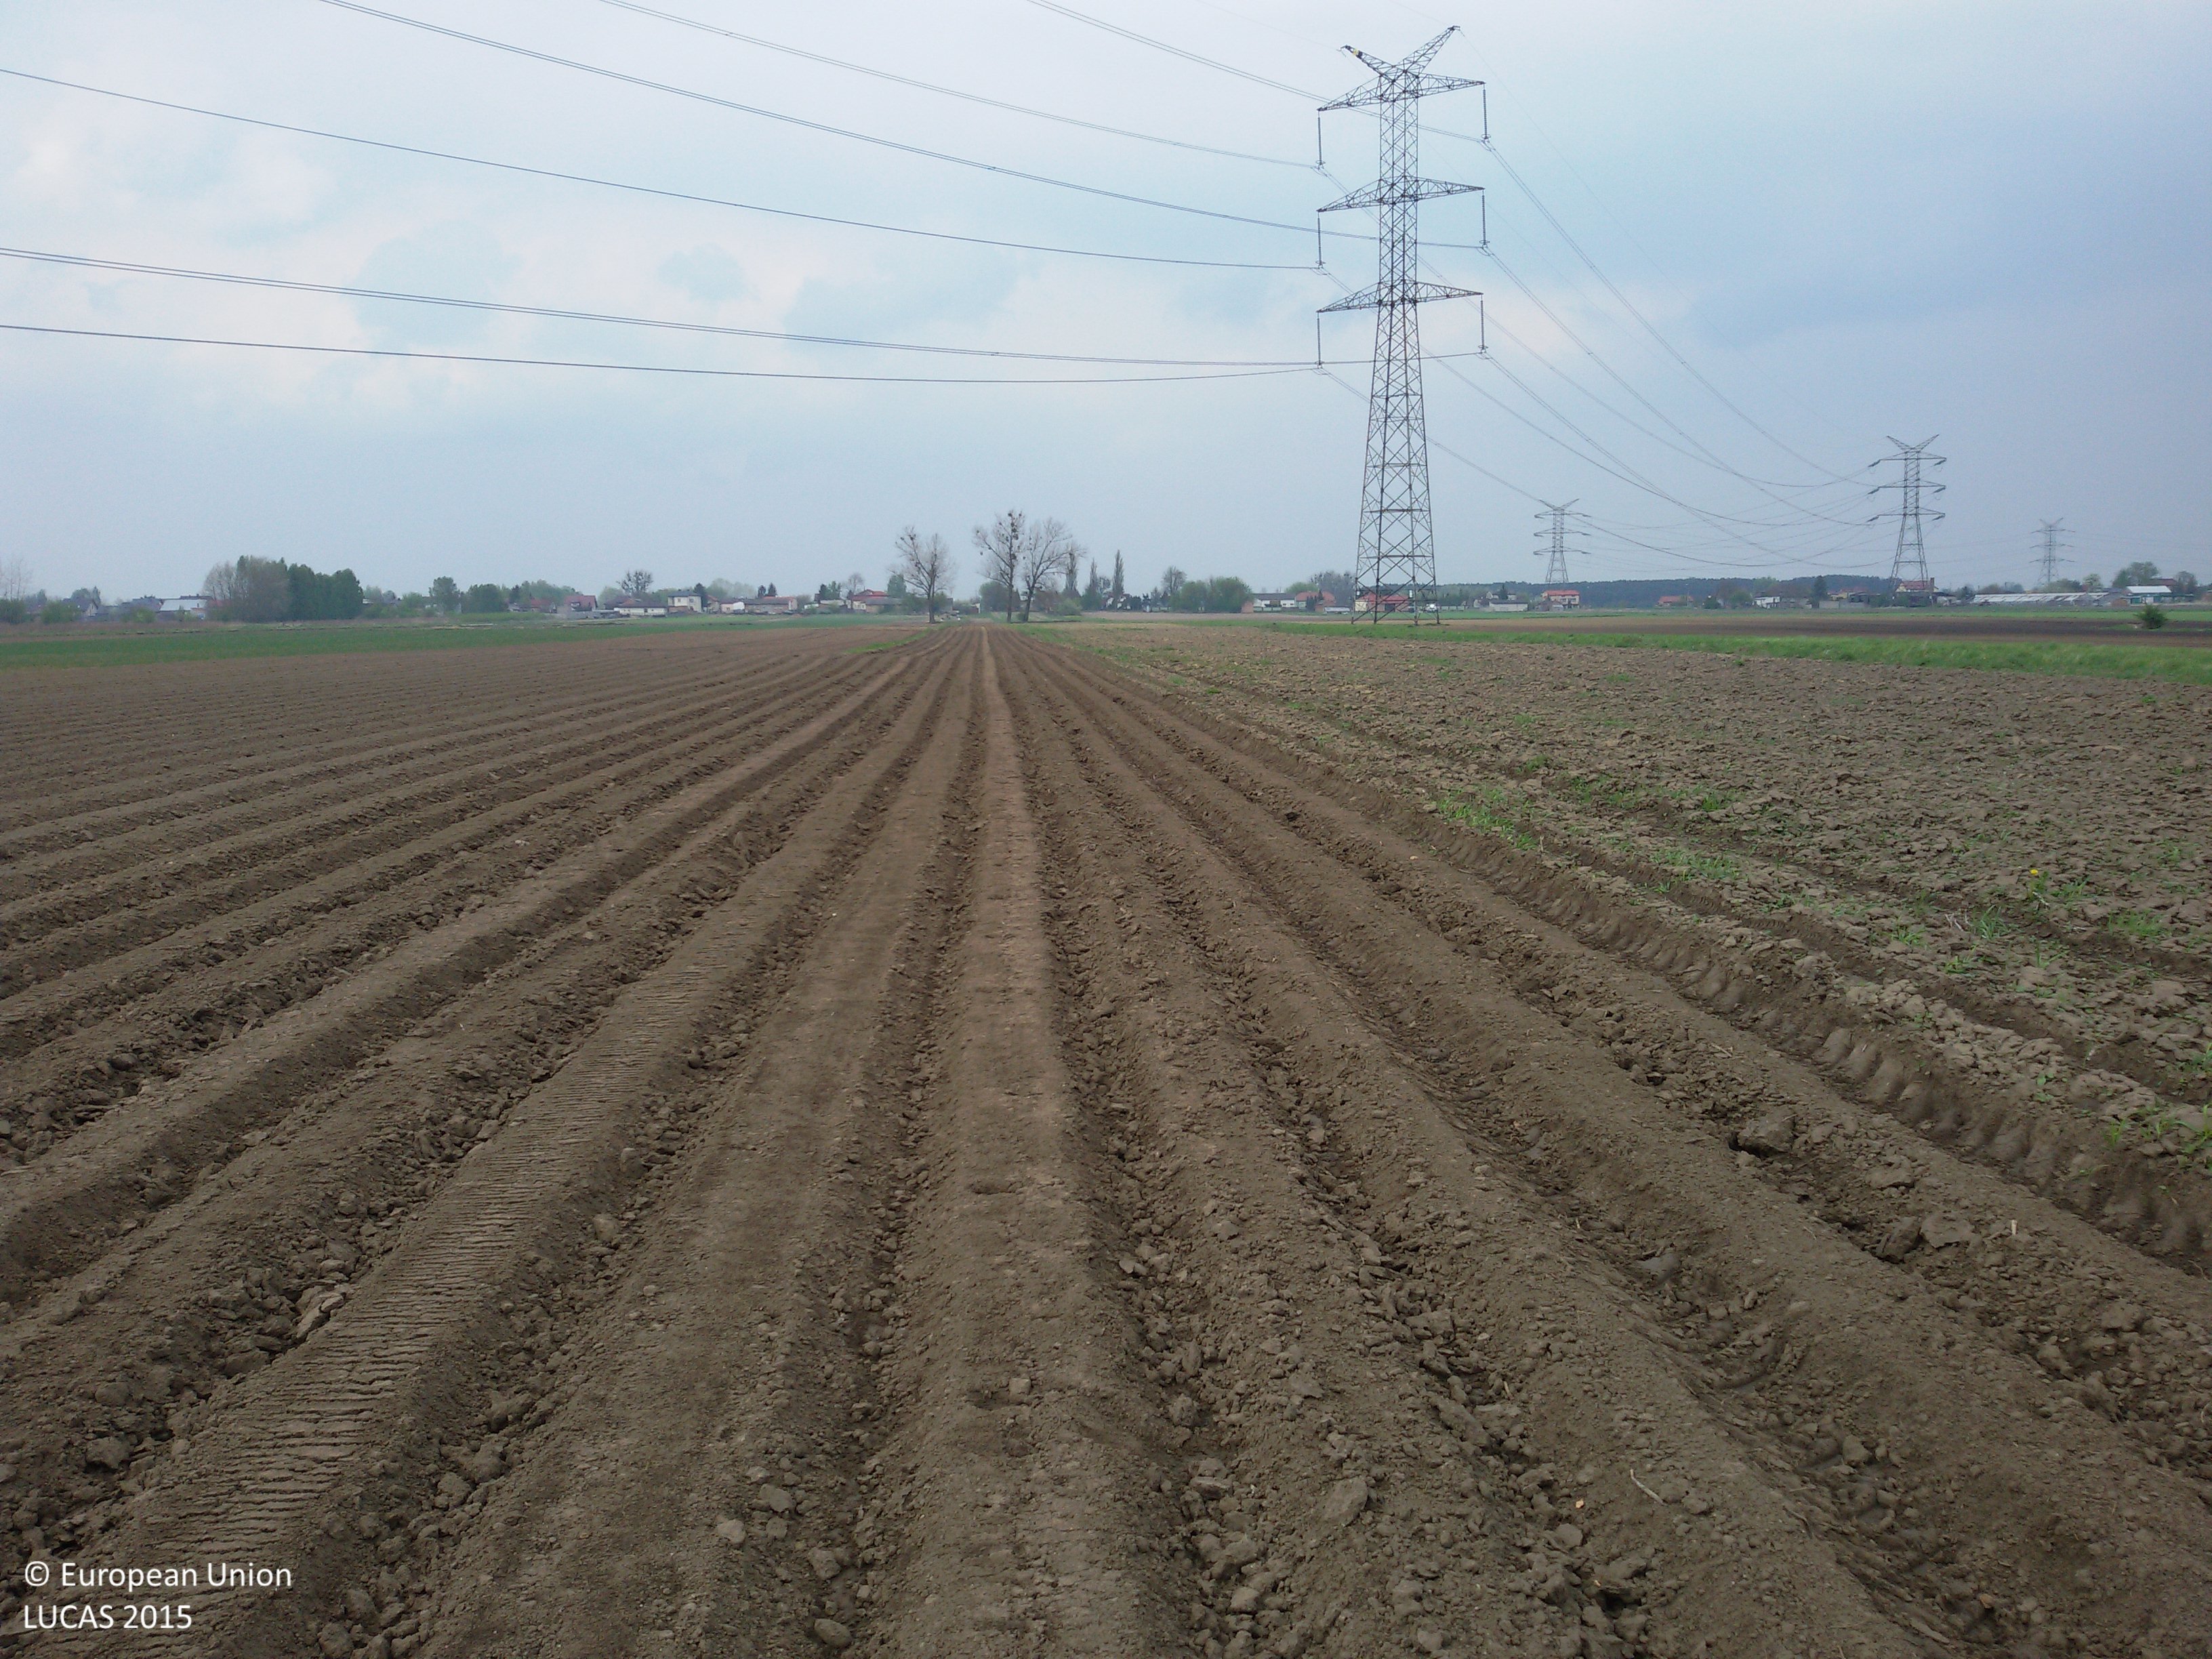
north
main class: Cropland
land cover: Potatoes
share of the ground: < 10 %
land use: Agriculture (excluding fallow land and kitchen gardens)
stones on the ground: < 10 %
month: May
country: PL
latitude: 52.2481
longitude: 20.7778
